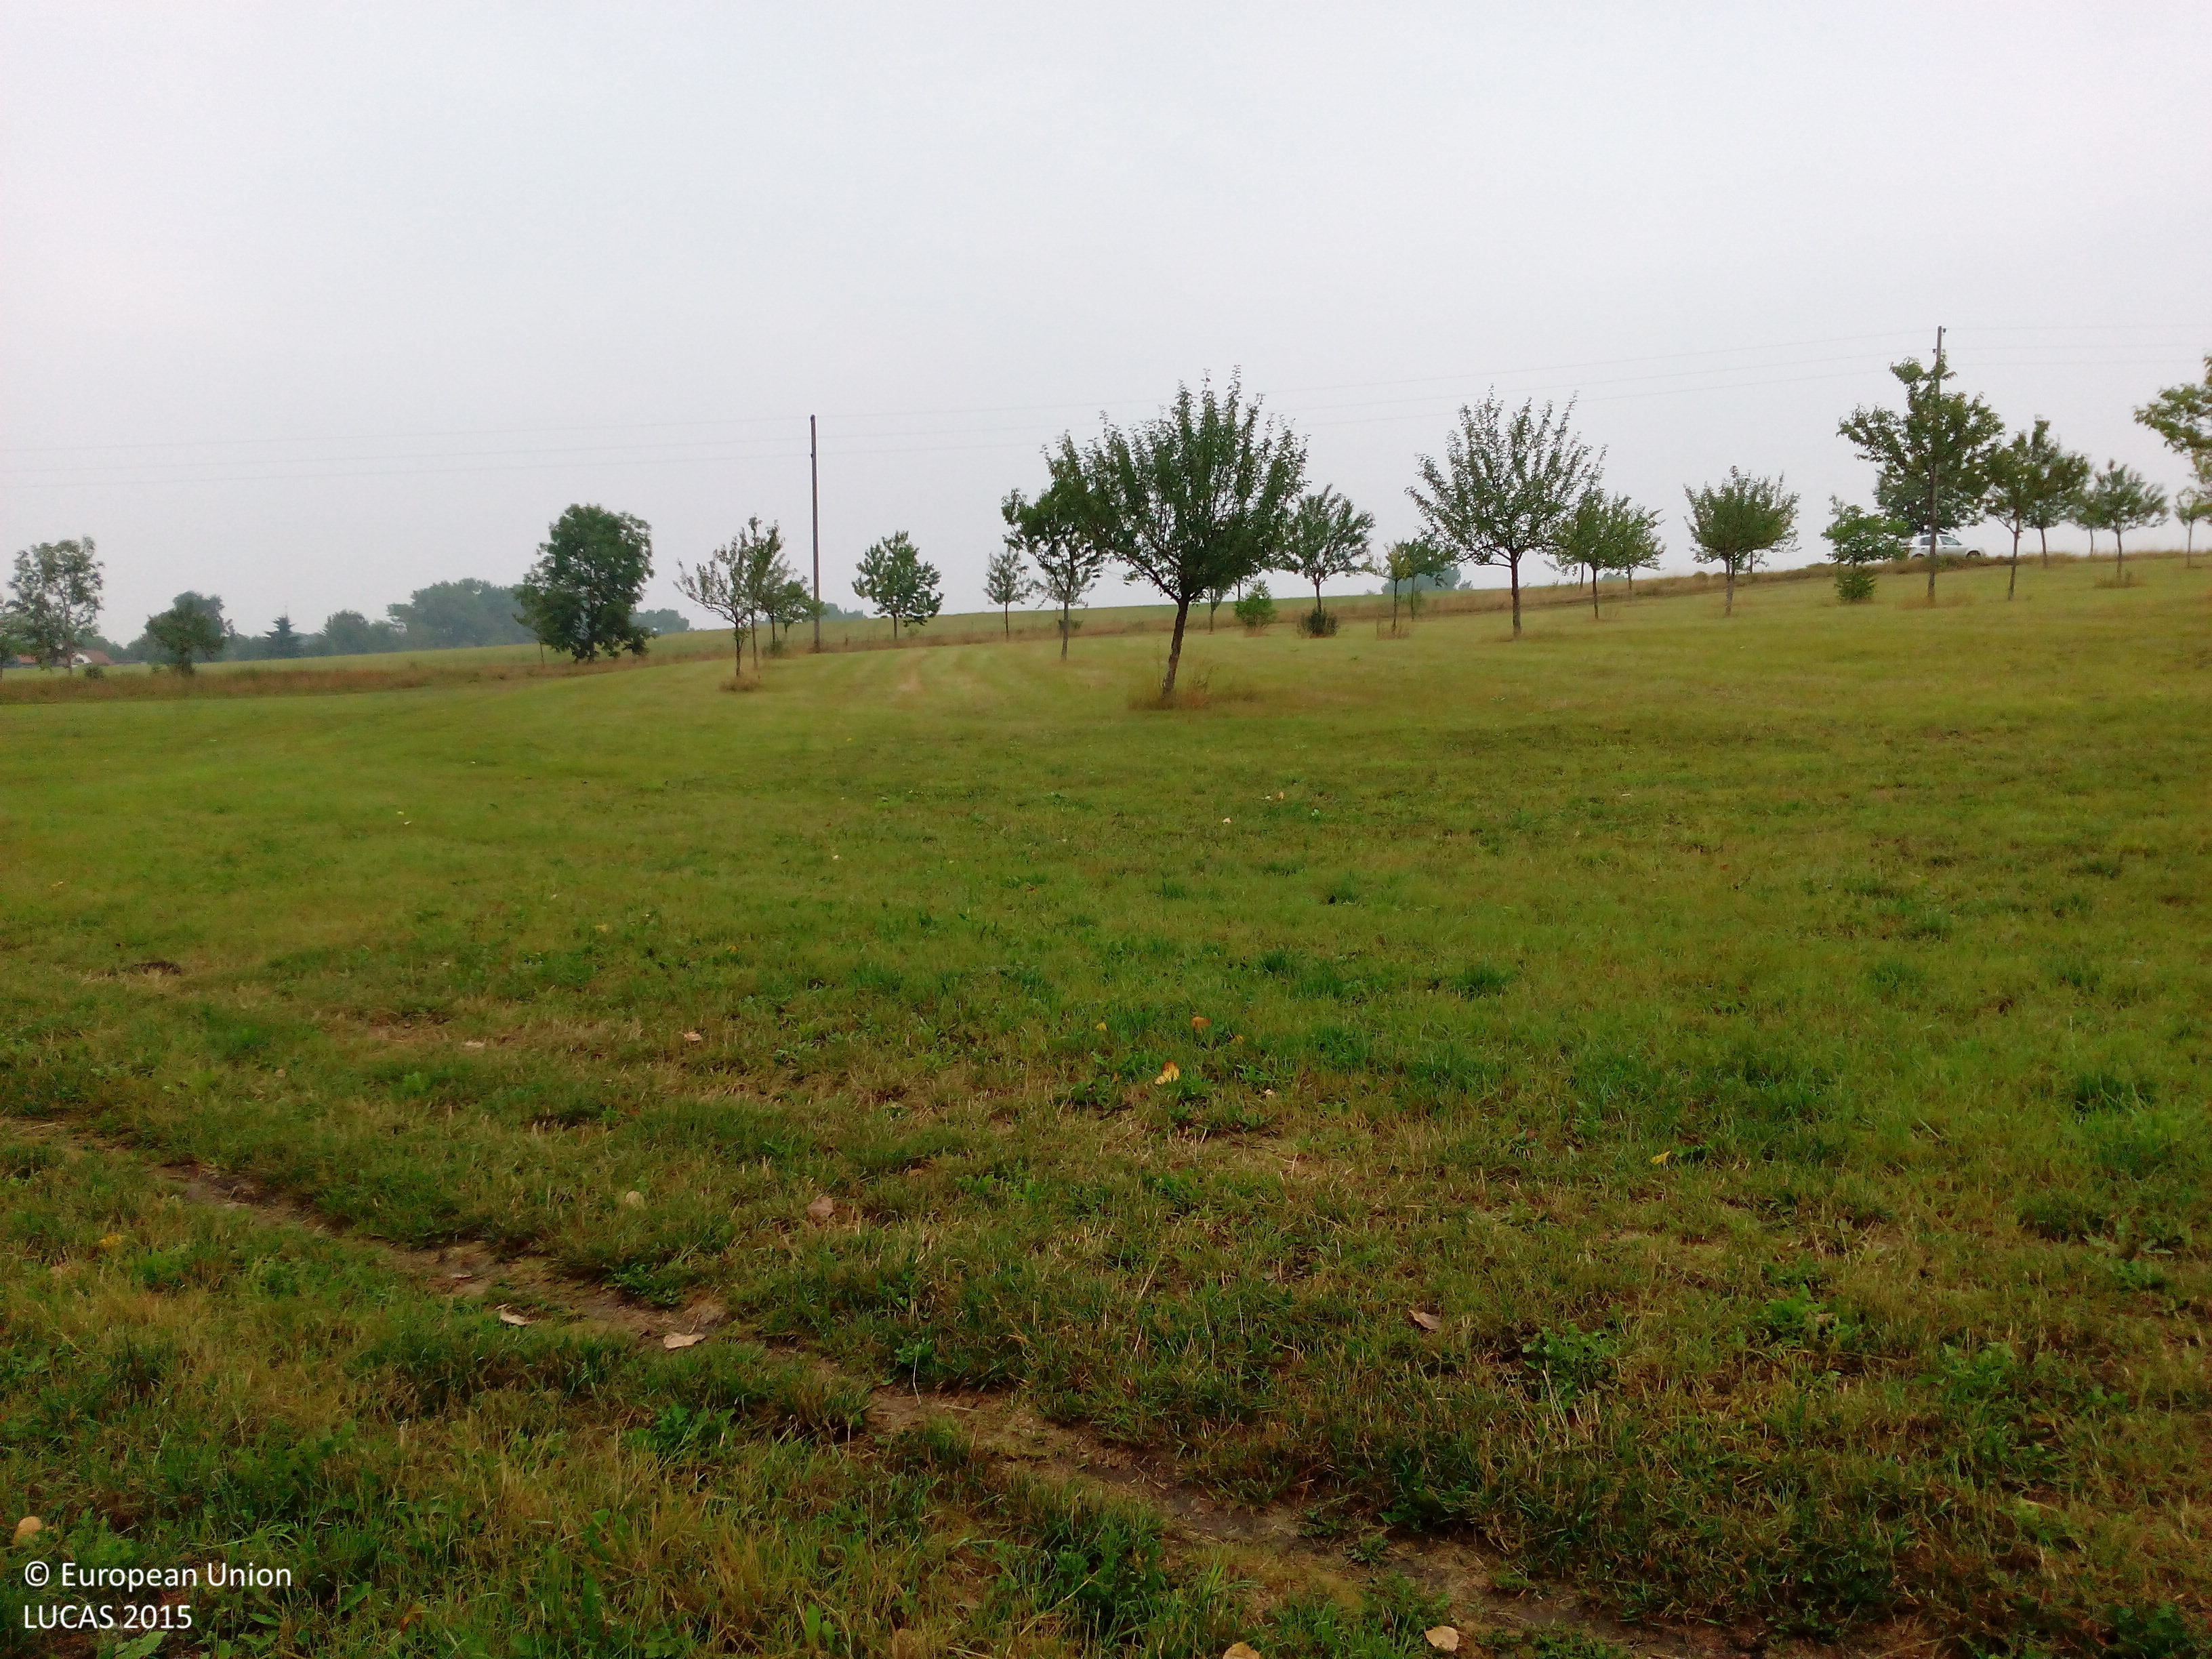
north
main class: Grassland
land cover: Grassland without tree/shrub cover
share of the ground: > 75 %
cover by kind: herbaceous plants 100 %
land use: Agriculture (excluding fallow land and kitchen gardens)
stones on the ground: 10 - 25 %
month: August
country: DE
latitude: 50.9184
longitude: 10.8390
